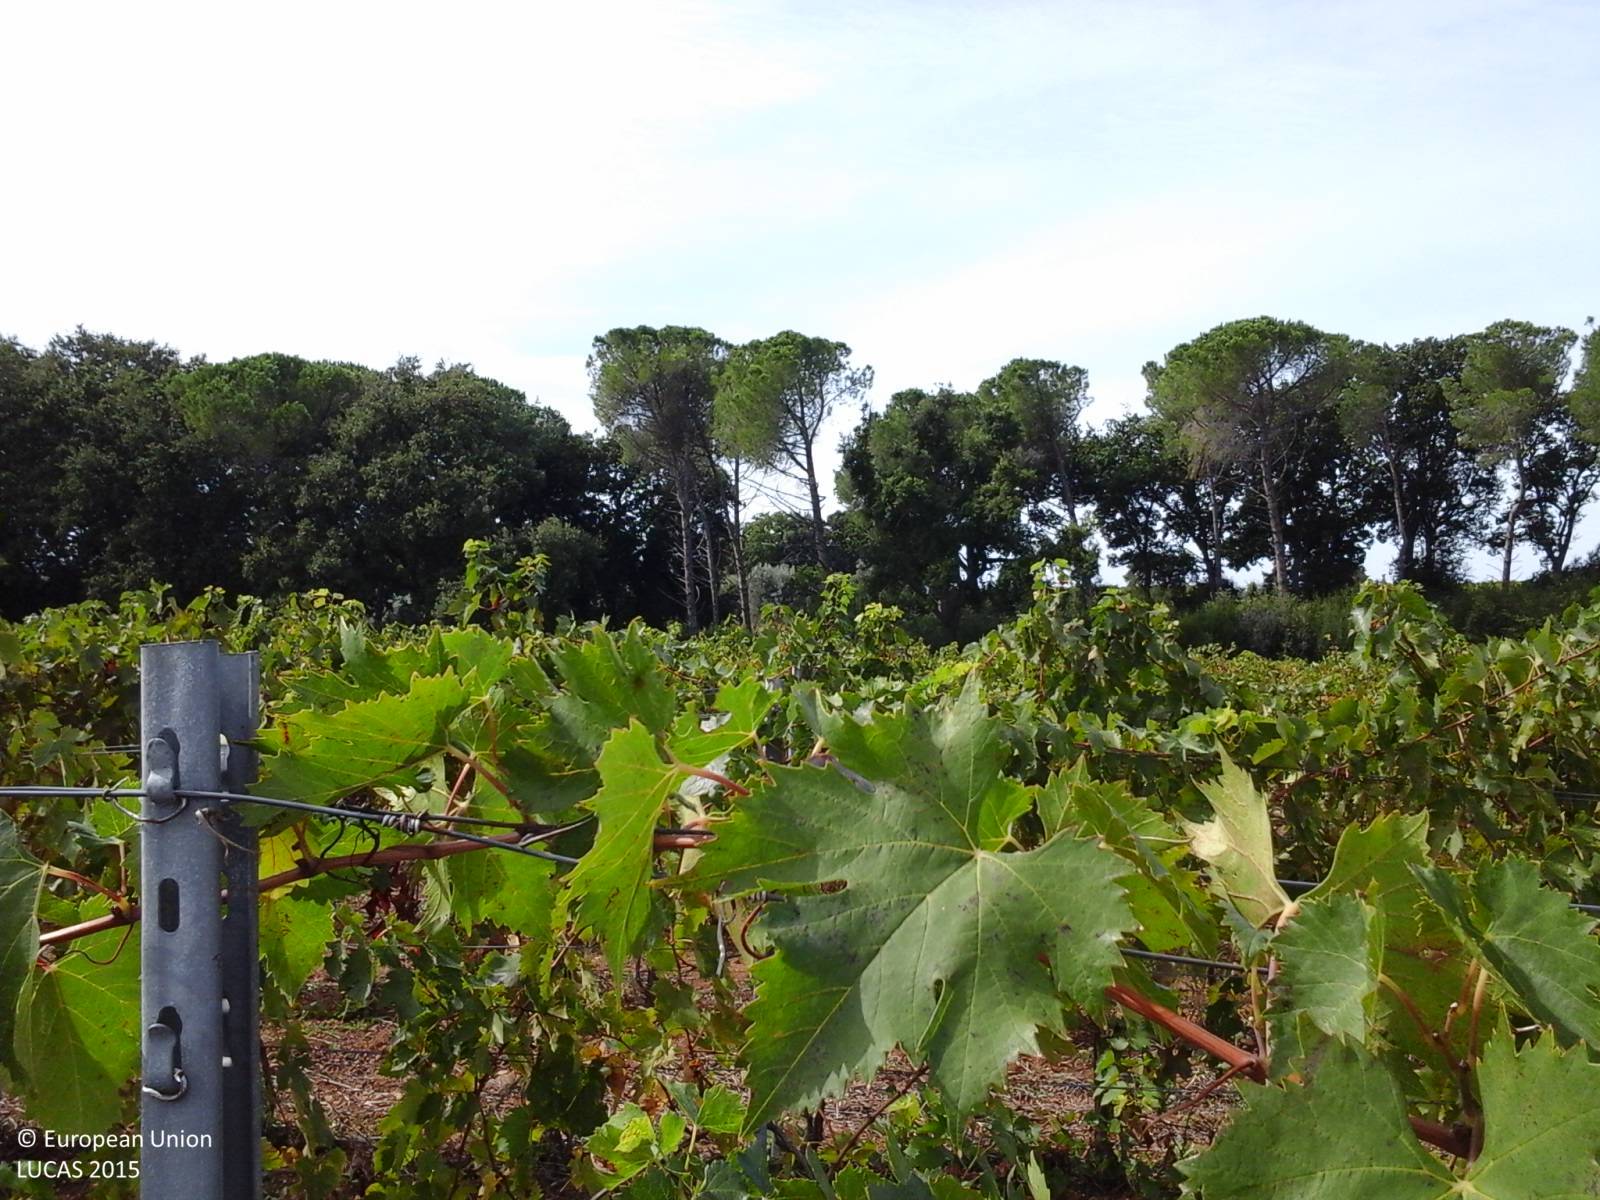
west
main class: Cropland
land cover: Vineyards
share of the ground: 50 - 75 %
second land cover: Other bare soil
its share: > 75 %
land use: Agriculture (excluding fallow land and kitchen gardens)
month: October
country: IT
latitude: 43.2481
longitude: 10.6017
